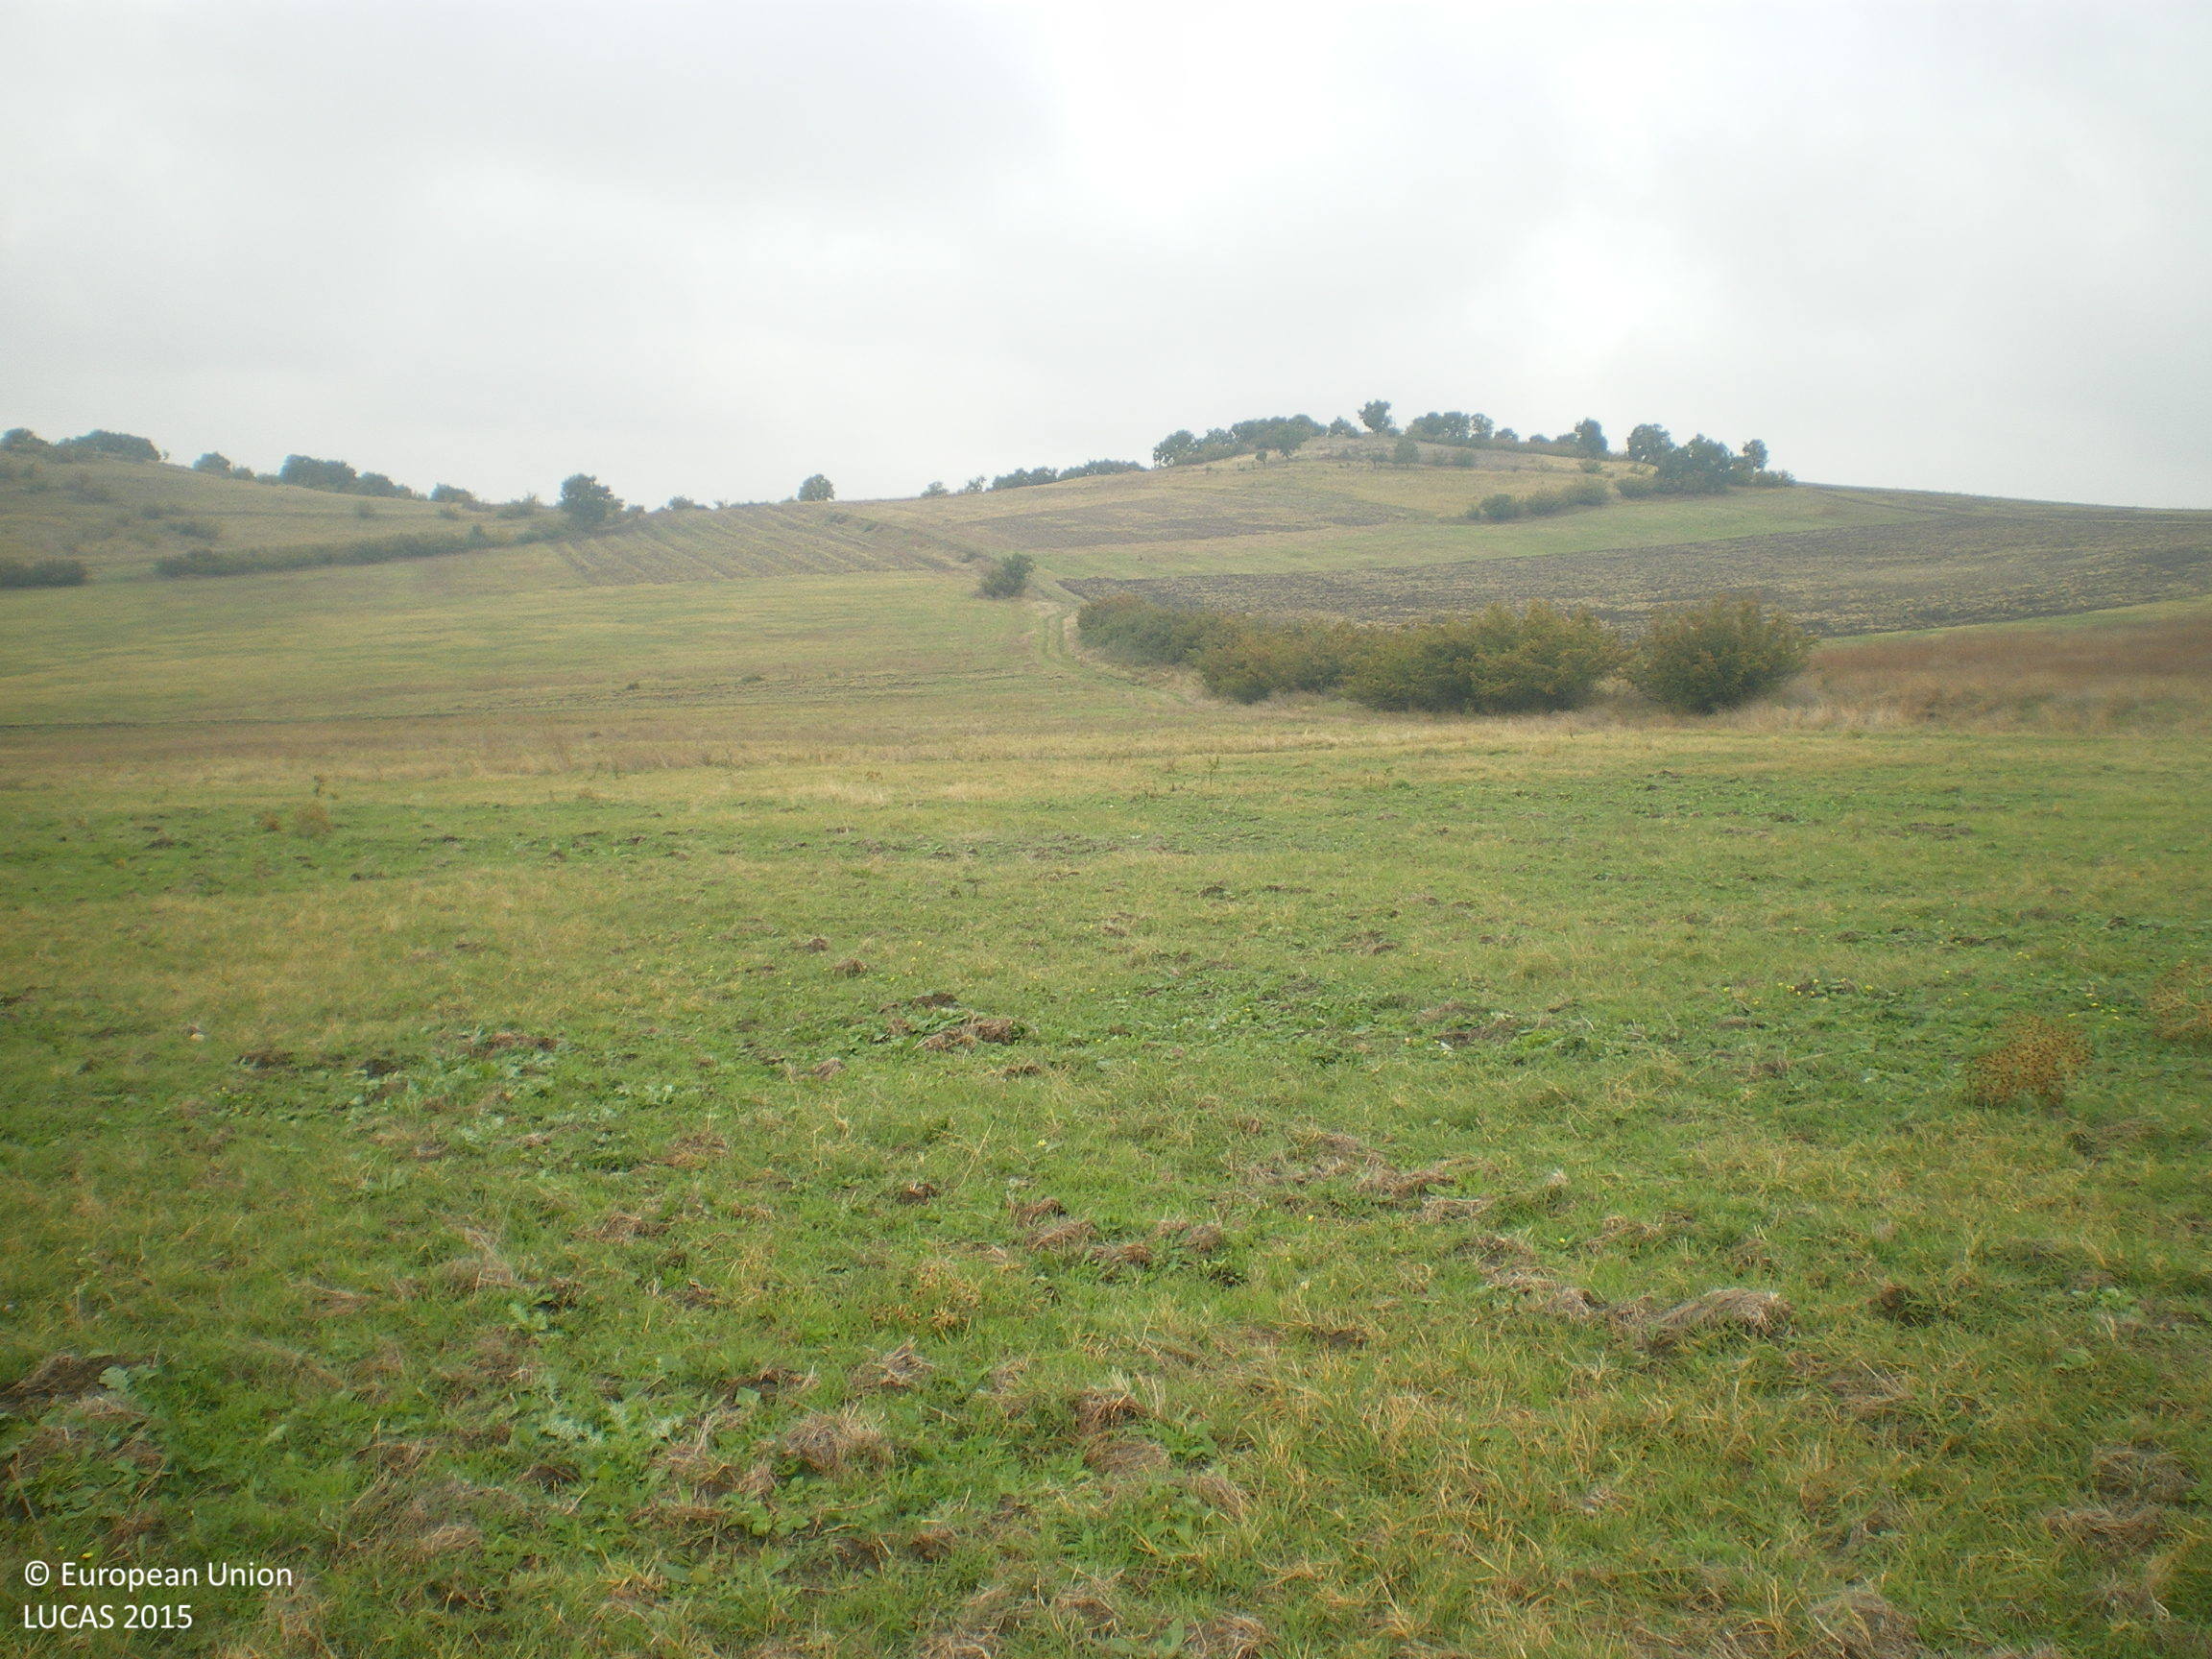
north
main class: Cropland
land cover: Common wheat
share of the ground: < 10 %
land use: Agriculture (excluding fallow land and kitchen gardens)
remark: Harvested field
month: October
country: BG
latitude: 41.8398
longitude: 26.1772
